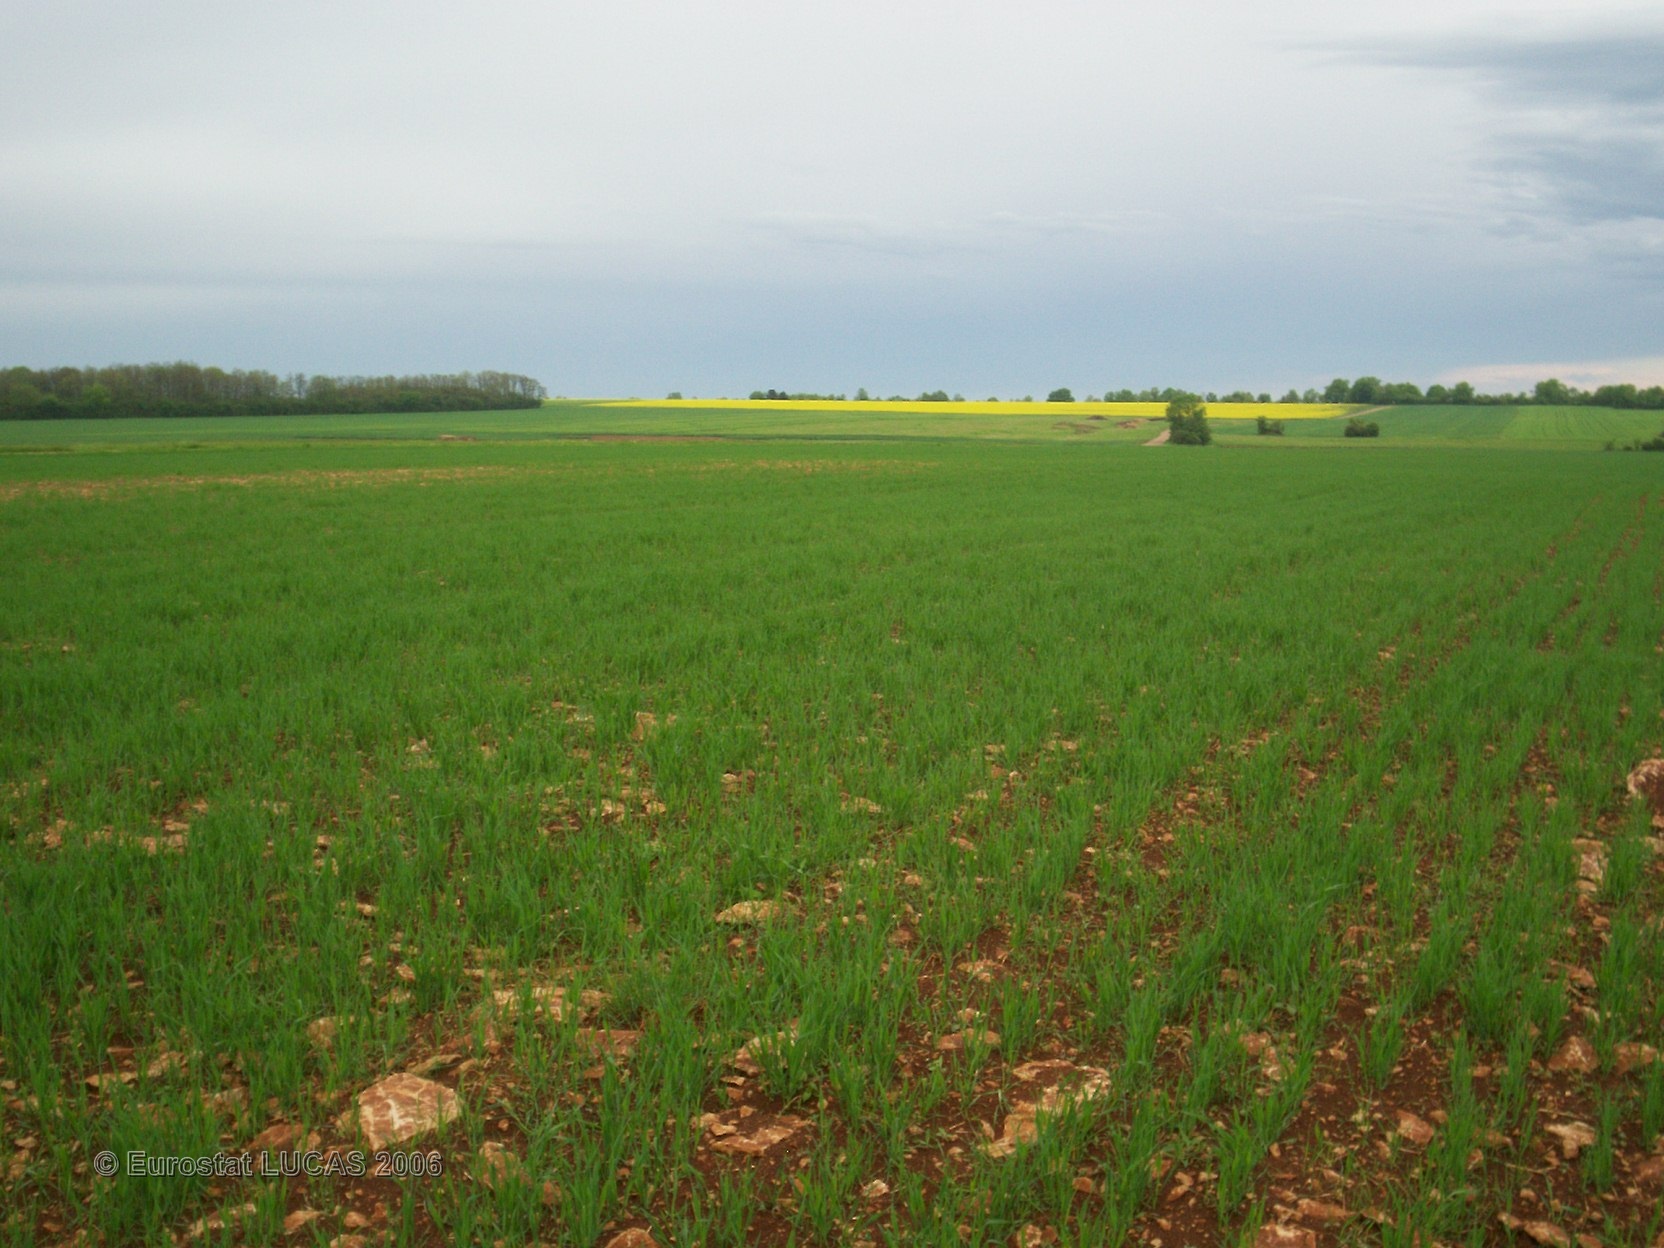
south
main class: Cropland
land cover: Oats
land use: Agriculture (excluding fallow land and kitchen gardens)
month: May
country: FR
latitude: 47.2612
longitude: 4.5946
